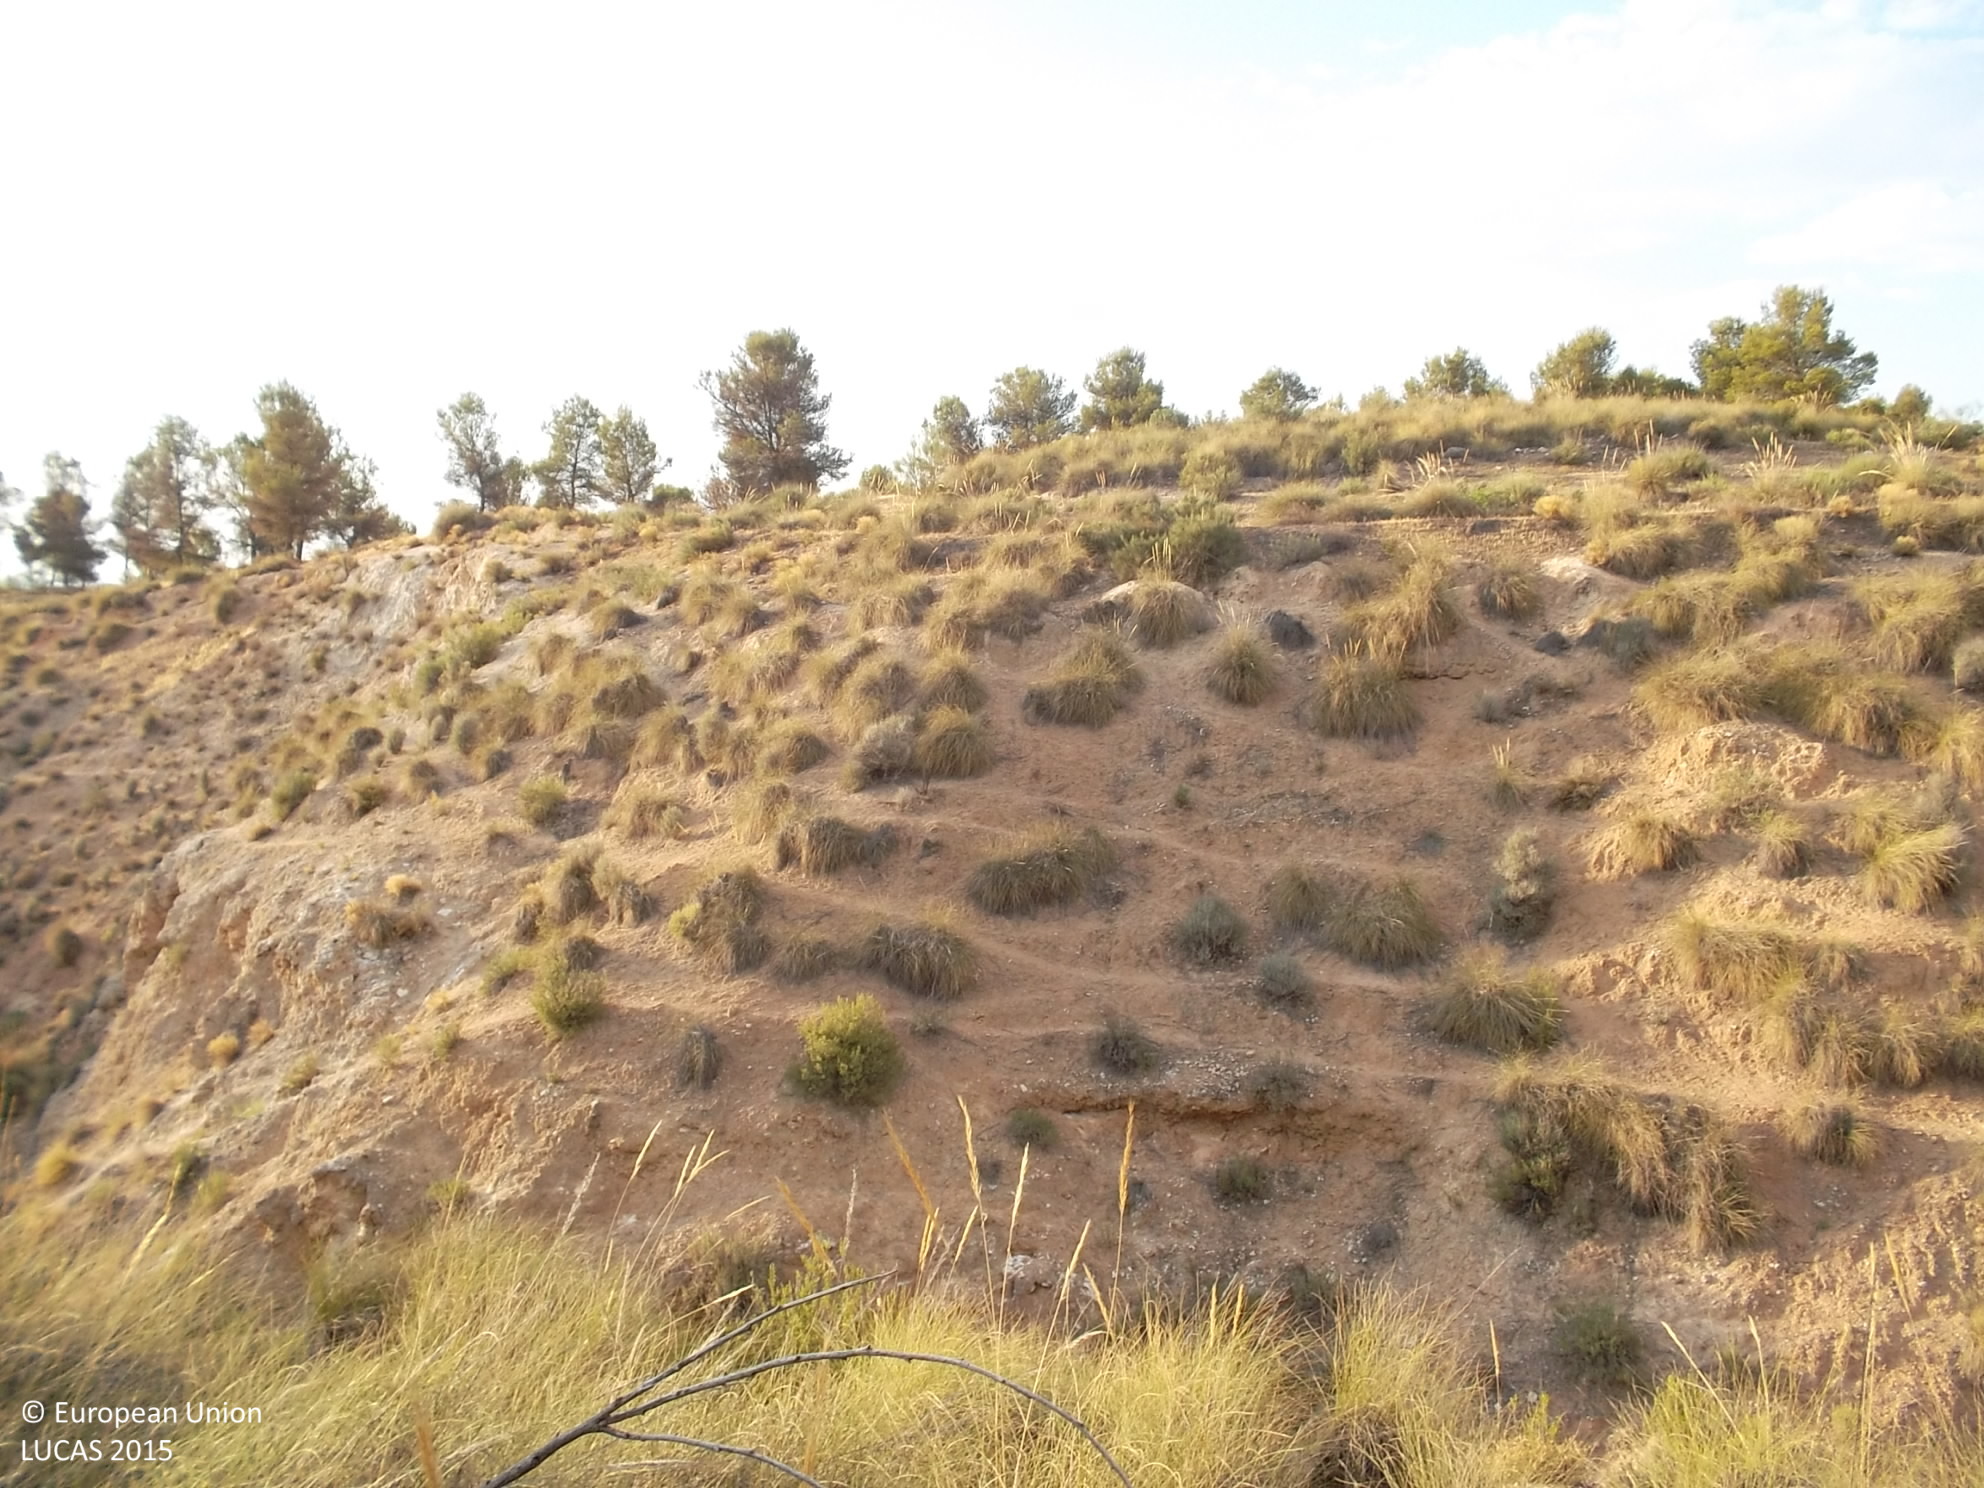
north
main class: Woodland
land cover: Pine dominated coniferous woodland
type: coniferous forest of the mediterranean region
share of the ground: 25 - 50 %
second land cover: Shrubland without tree cover
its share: 25 - 50 %
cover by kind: shrubs 40 %, coniferous forest trees 30 %, herbaceous plants 30 %
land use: Forestry
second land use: Agriculture (excluding fallow land and kitchen gardens)
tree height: > 5 m
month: June
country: ES
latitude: 37.8097
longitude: -3.2285
